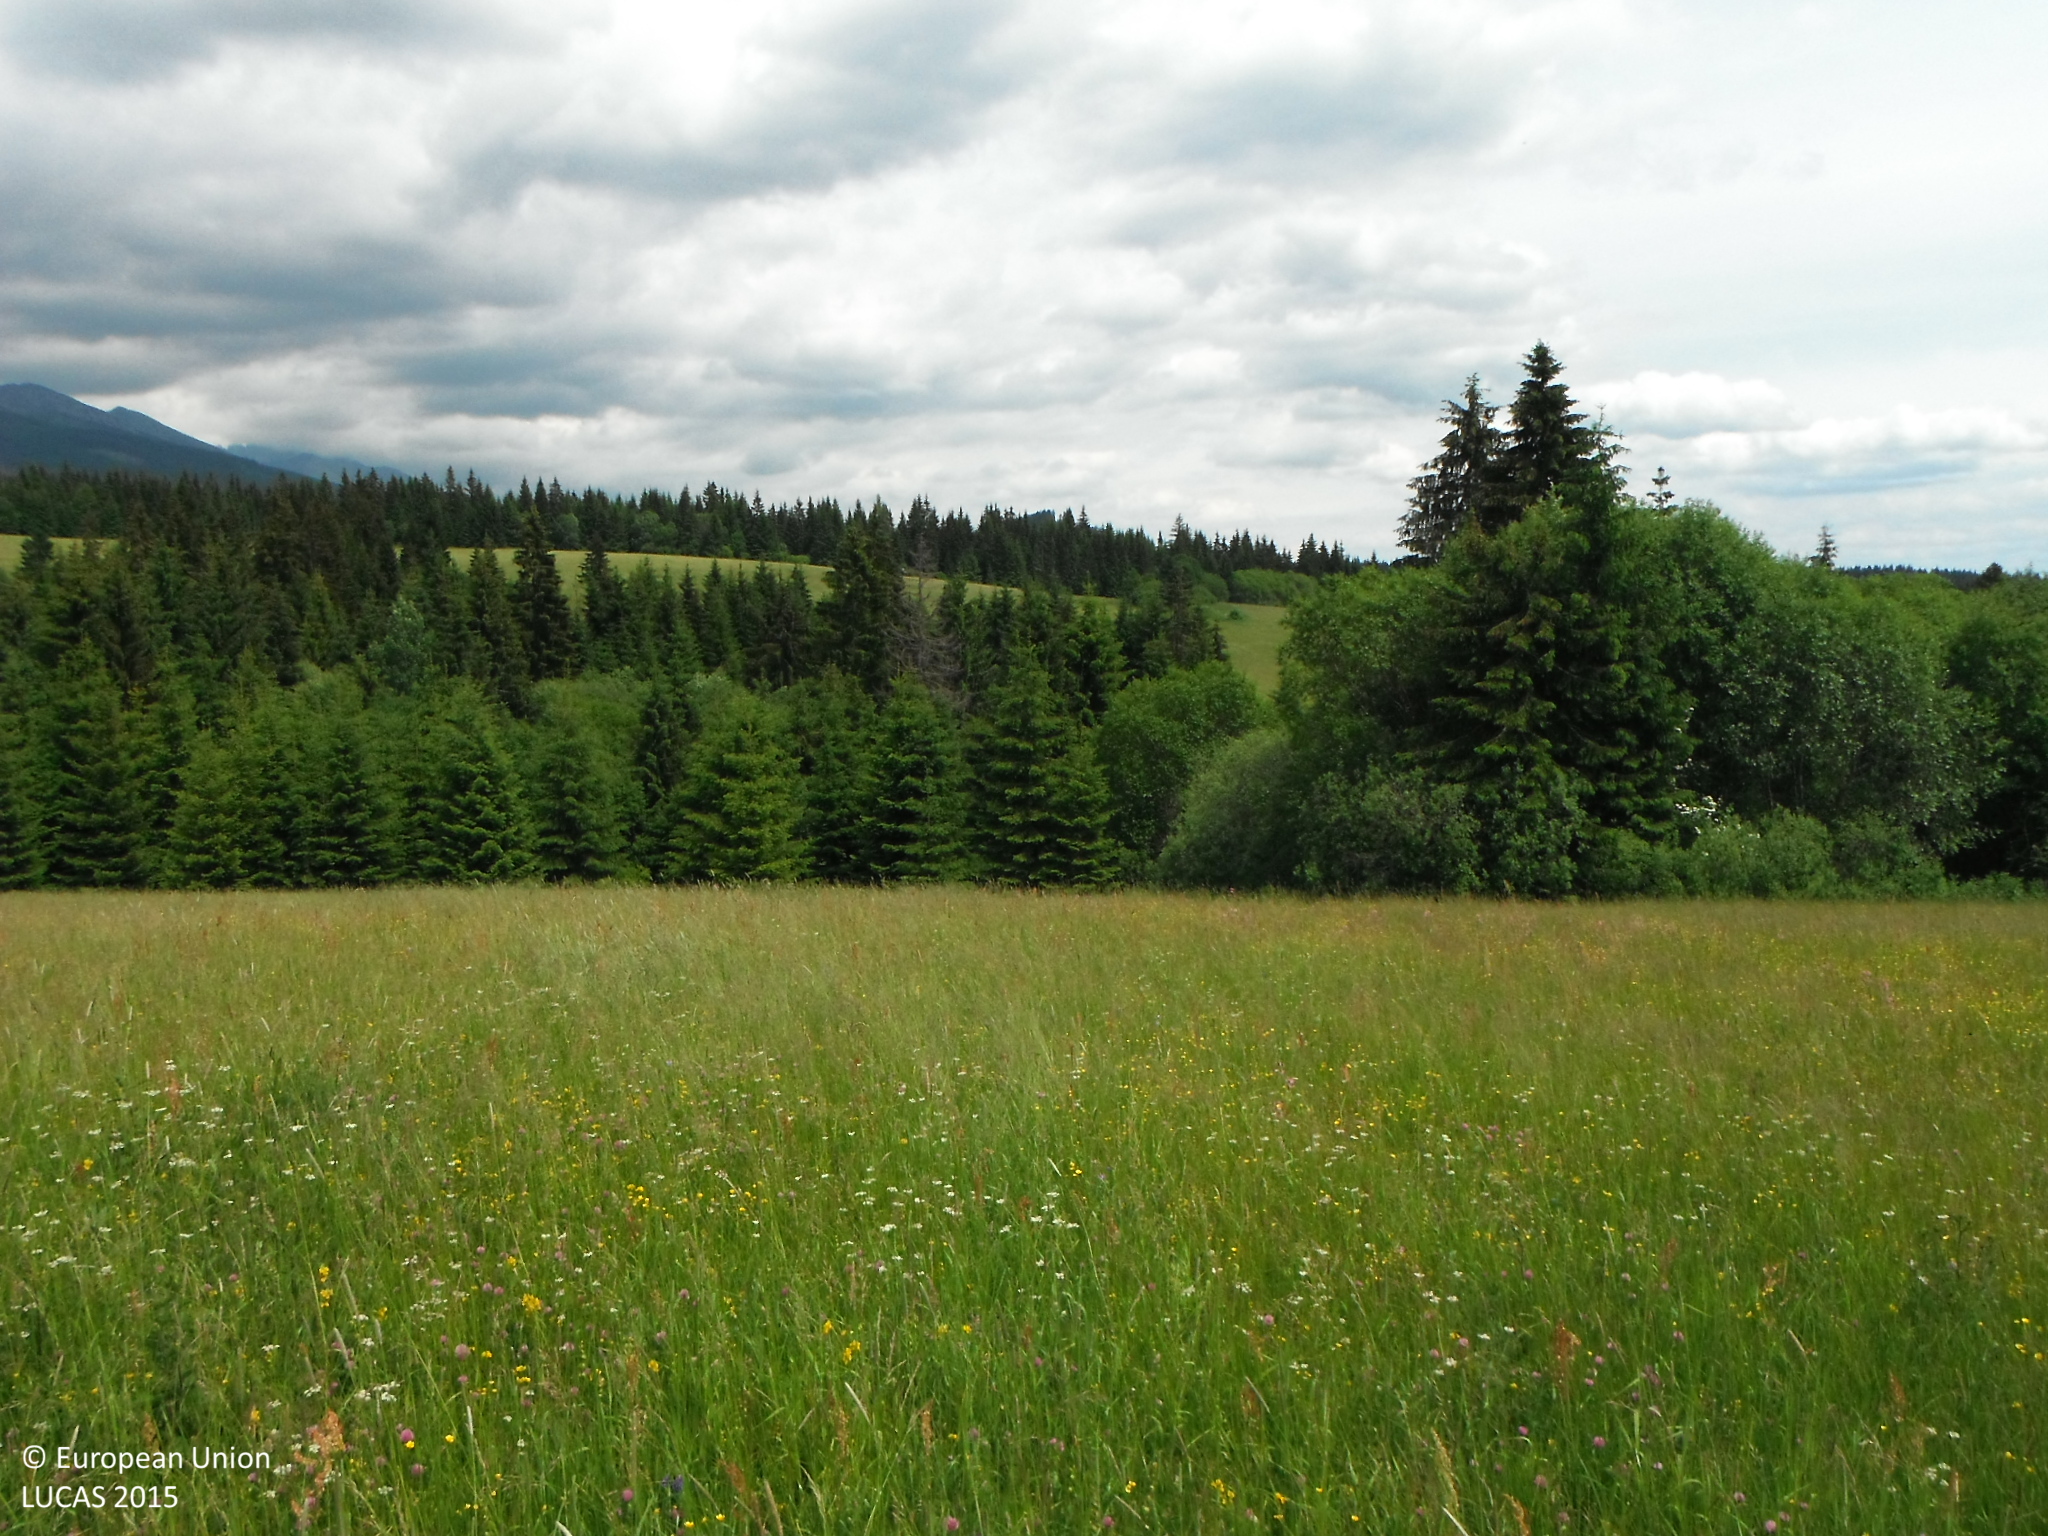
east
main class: Grassland
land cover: Grassland without tree/shrub cover
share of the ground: > 75 %
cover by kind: herbaceous plants 100 %
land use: Agriculture (excluding fallow land and kitchen gardens)
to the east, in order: Grassland without tree/shrub cover; Shrubland with sparse tree cover; Spruce dominated coniferous woodland; Ditches and canals; Spruce dominated coniferous woodland; Grassland without tree/shrub cover
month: June
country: SK
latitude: 49.1149
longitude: 19.9357
